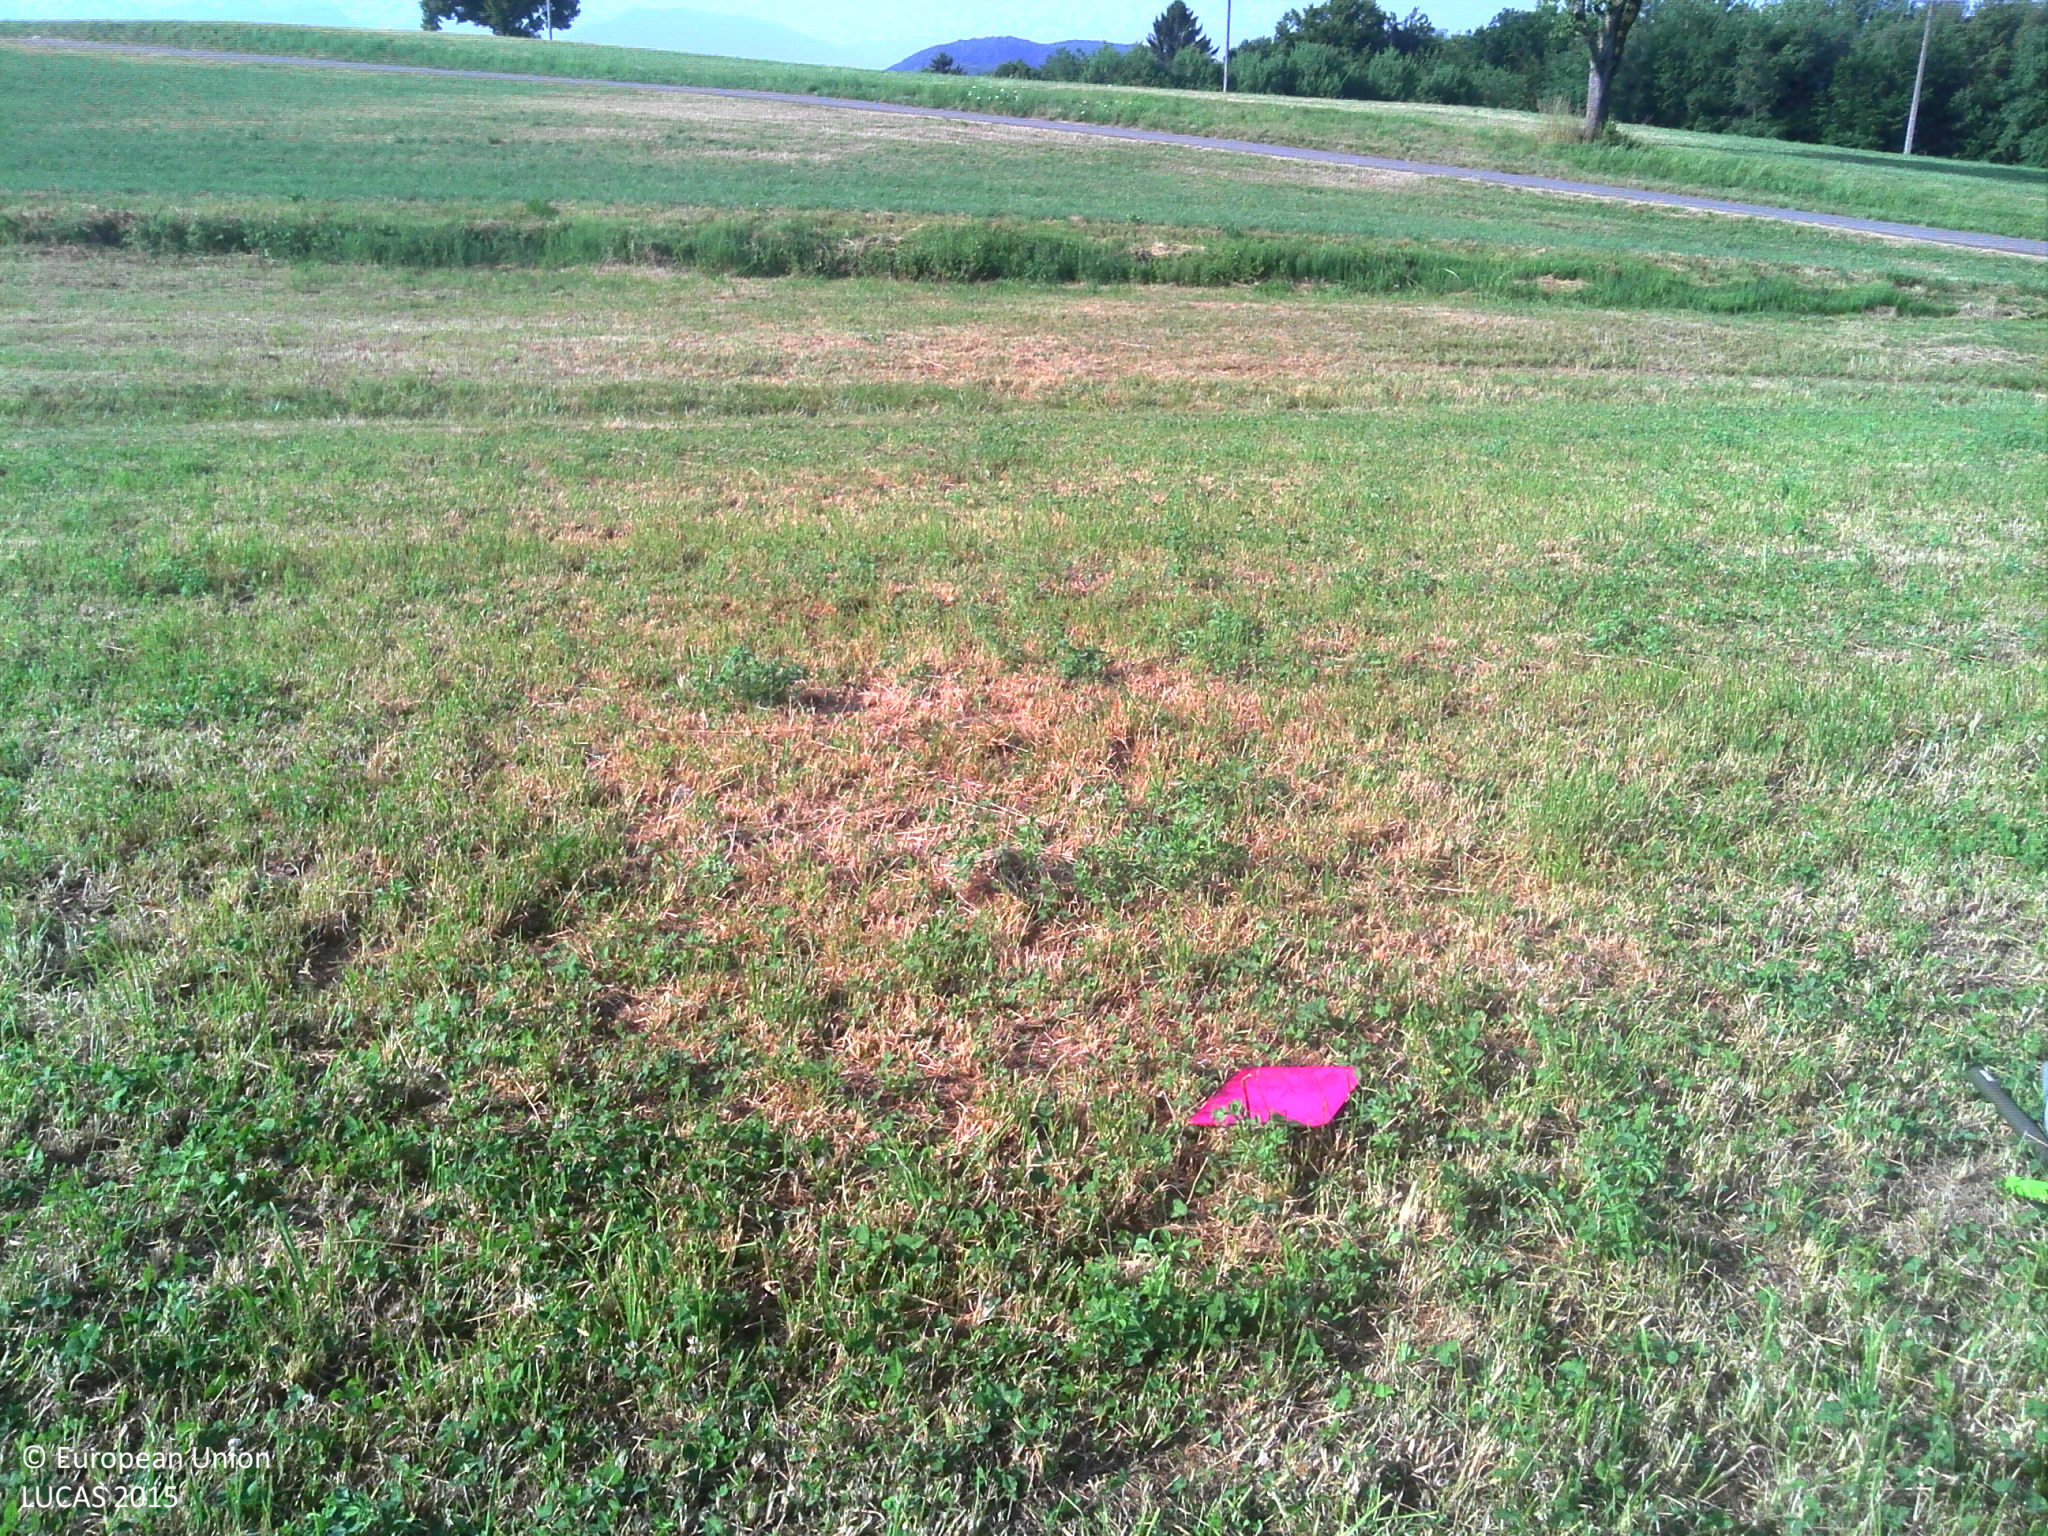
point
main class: Grassland
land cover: Grassland without tree/shrub cover
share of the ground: > 75 %
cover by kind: herbaceous plants 100 %
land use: Agriculture (excluding fallow land and kitchen gardens)
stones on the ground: < 10 %
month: July
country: FR
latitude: 46.0282
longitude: 6.1151
